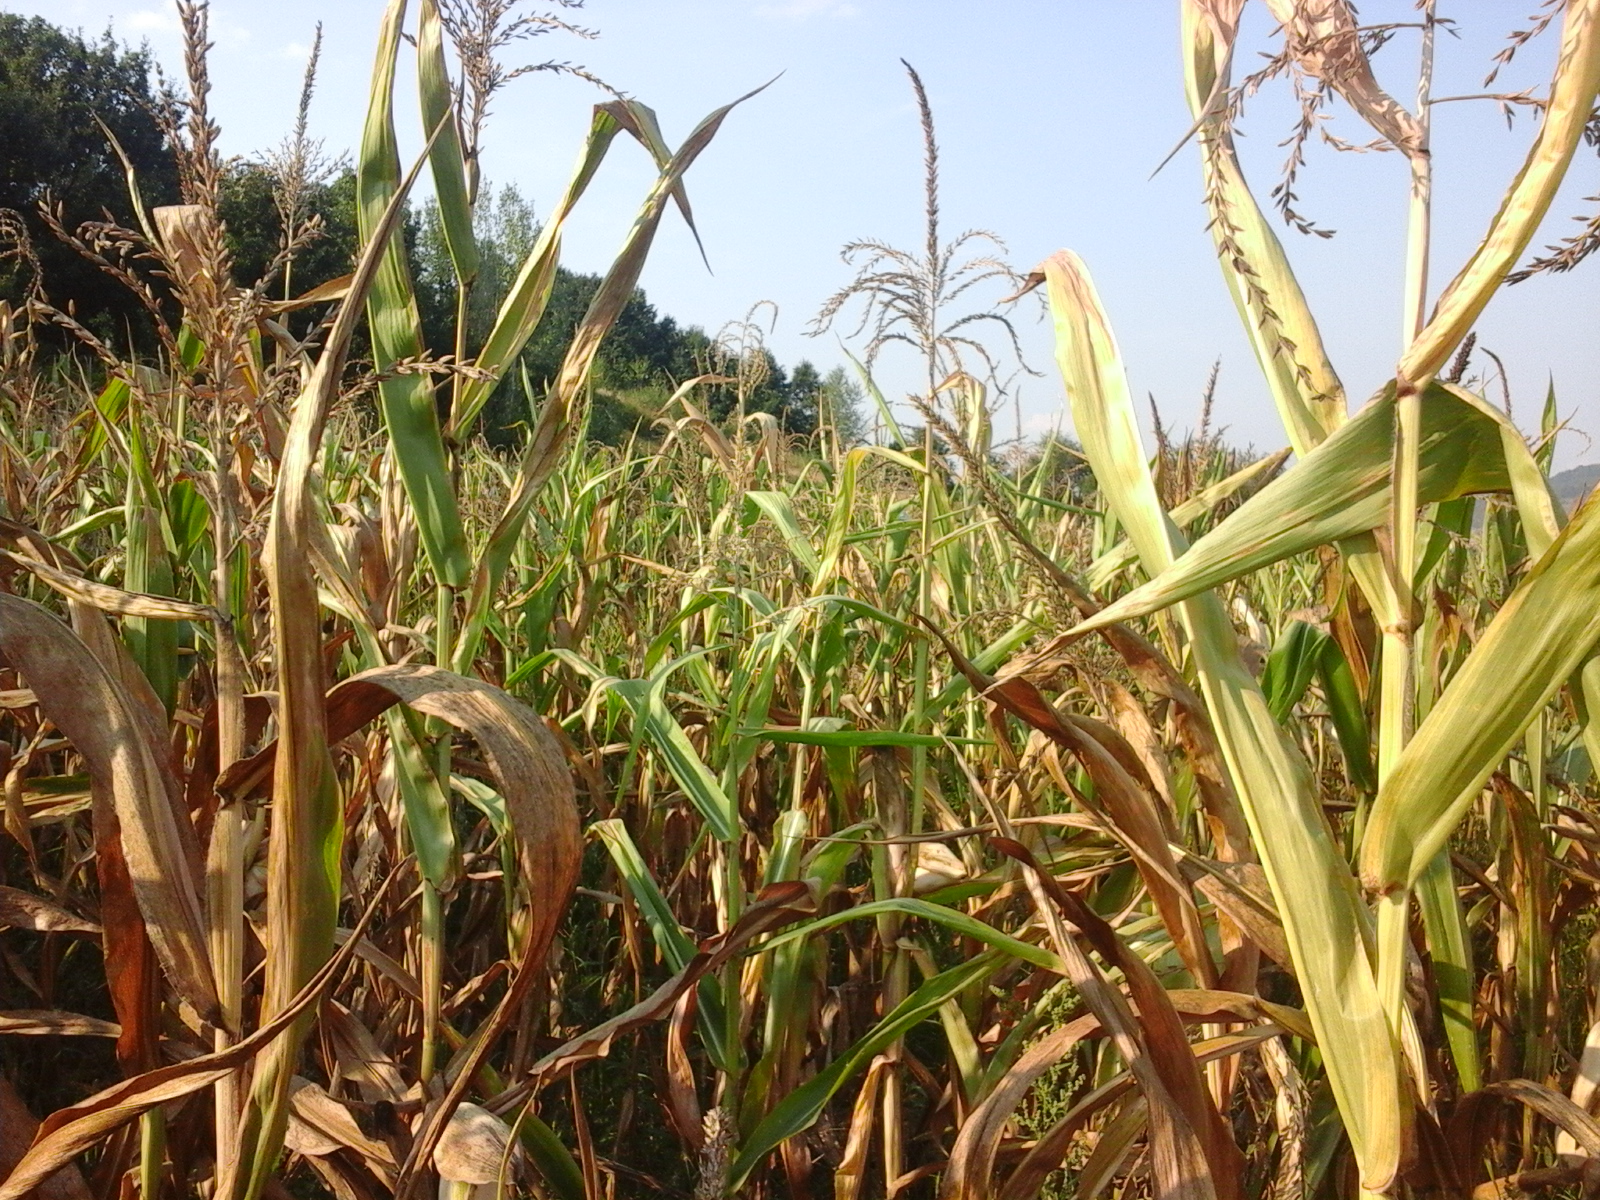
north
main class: Cropland
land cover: Maize
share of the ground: > 75 %
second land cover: Spontaneously vegetated surfaces
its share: 10 - 25 %
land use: Agriculture (excluding fallow land and kitchen gardens)
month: August
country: RO
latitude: 46.2537
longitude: 22.3319
